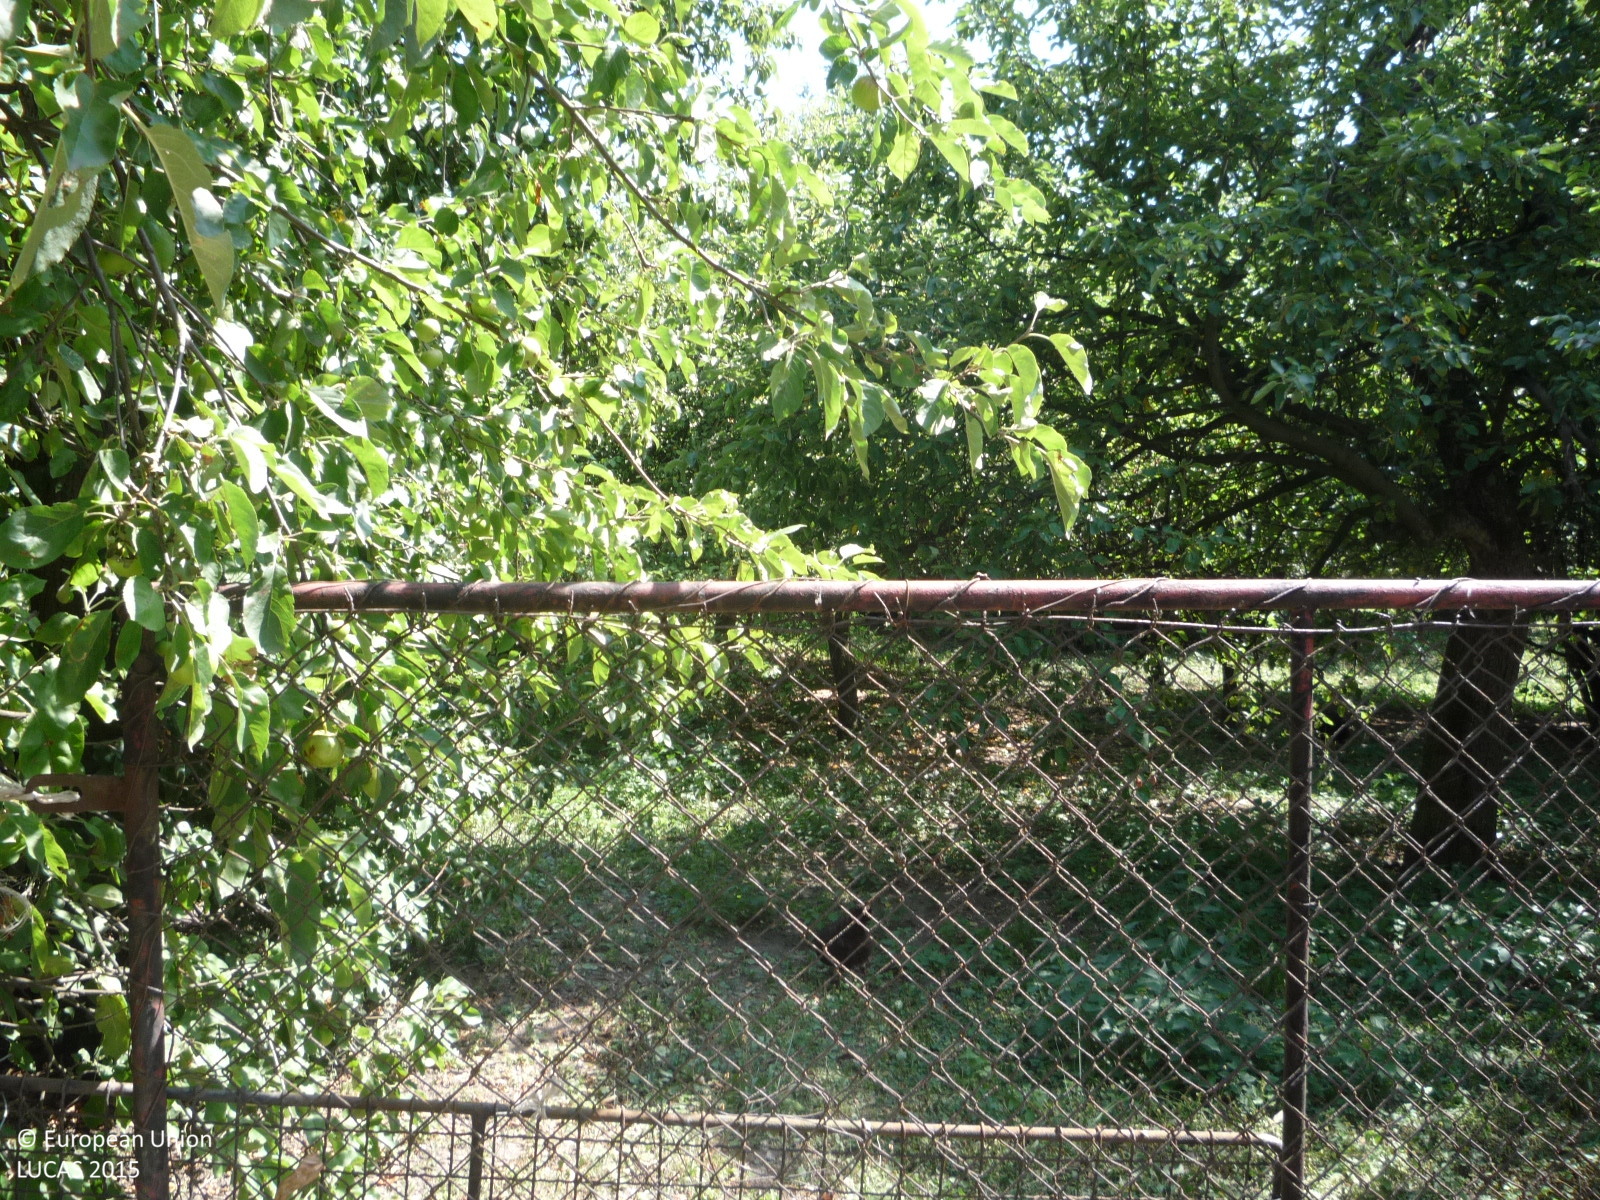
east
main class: Cropland
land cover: Apple fruit
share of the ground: > 75 %
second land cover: Grassland without tree/shrub cover
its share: 10 - 25 %
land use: Kitchen garden
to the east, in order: Apple fruit; Grassland with sparse tree/shrub cover; Artificial constructions in urban areas; Grassland without tree/shrub cover; Broadleaved woodland; Grassland with sparse tree/shrub cover; Broadleaved woodland; Grassland without tree/shrub cover
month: August
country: CZ
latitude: 50.5683
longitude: 15.2415
